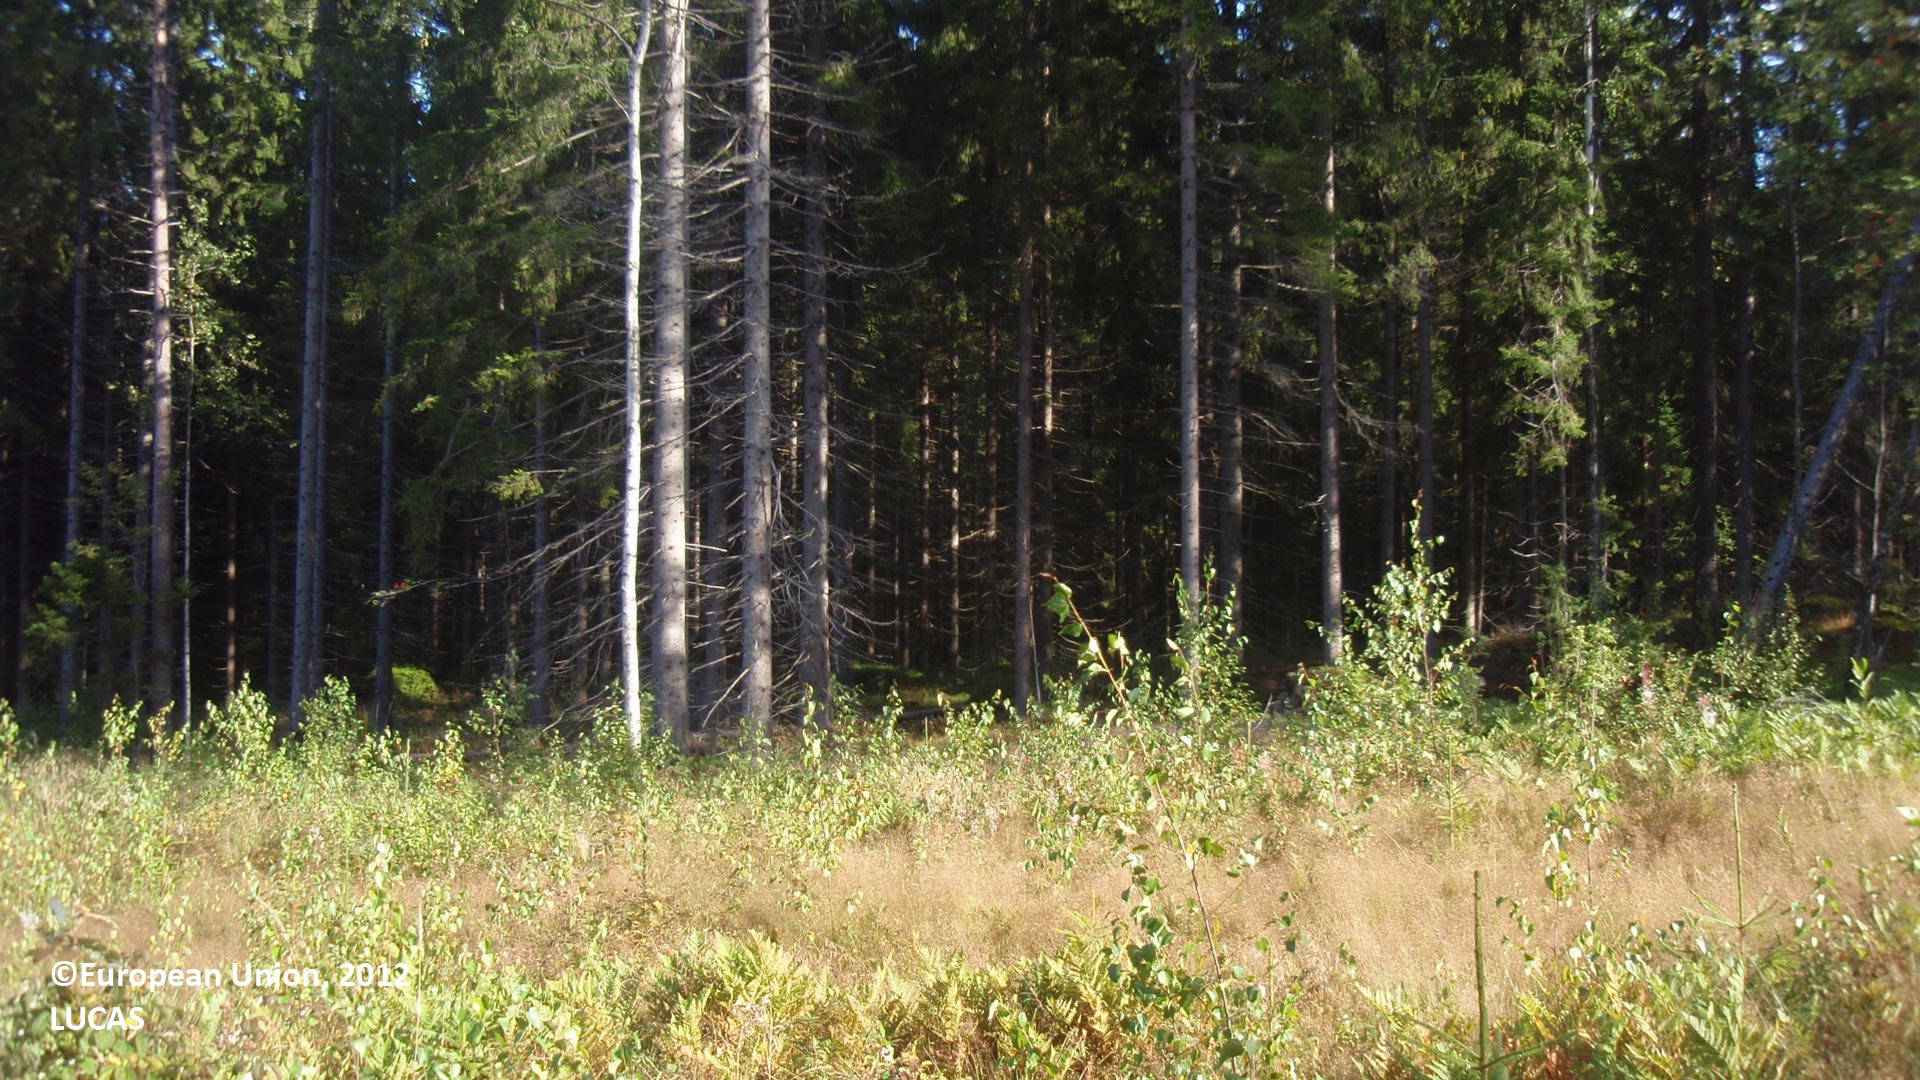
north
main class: Shrubland
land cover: Shrubland with sparse tree cover
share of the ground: > 75 %
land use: Forestry
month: August
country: FI
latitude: 60.6509
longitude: 27.1666
